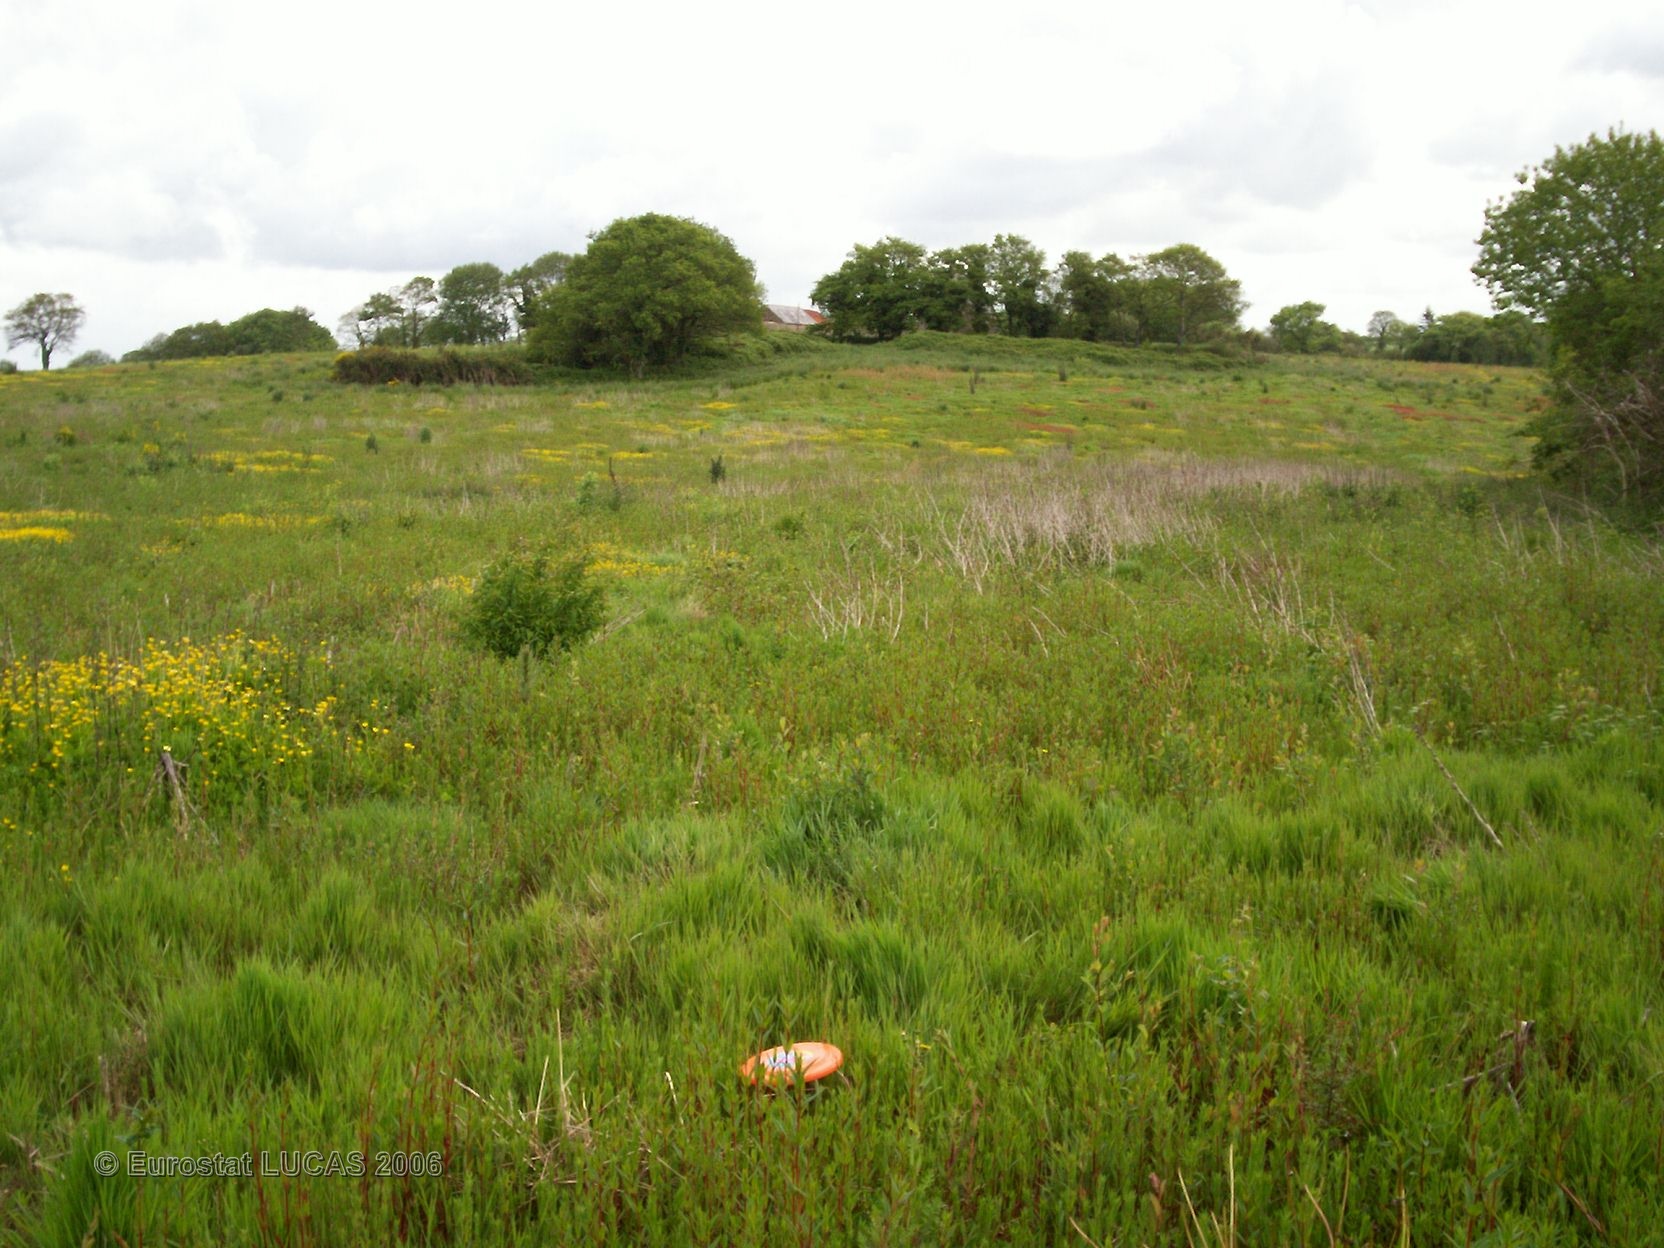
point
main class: Grassland
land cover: Grassland without tree/shrub cover
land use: Fallow land
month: May
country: FR
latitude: 48.0123
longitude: -3.9058
